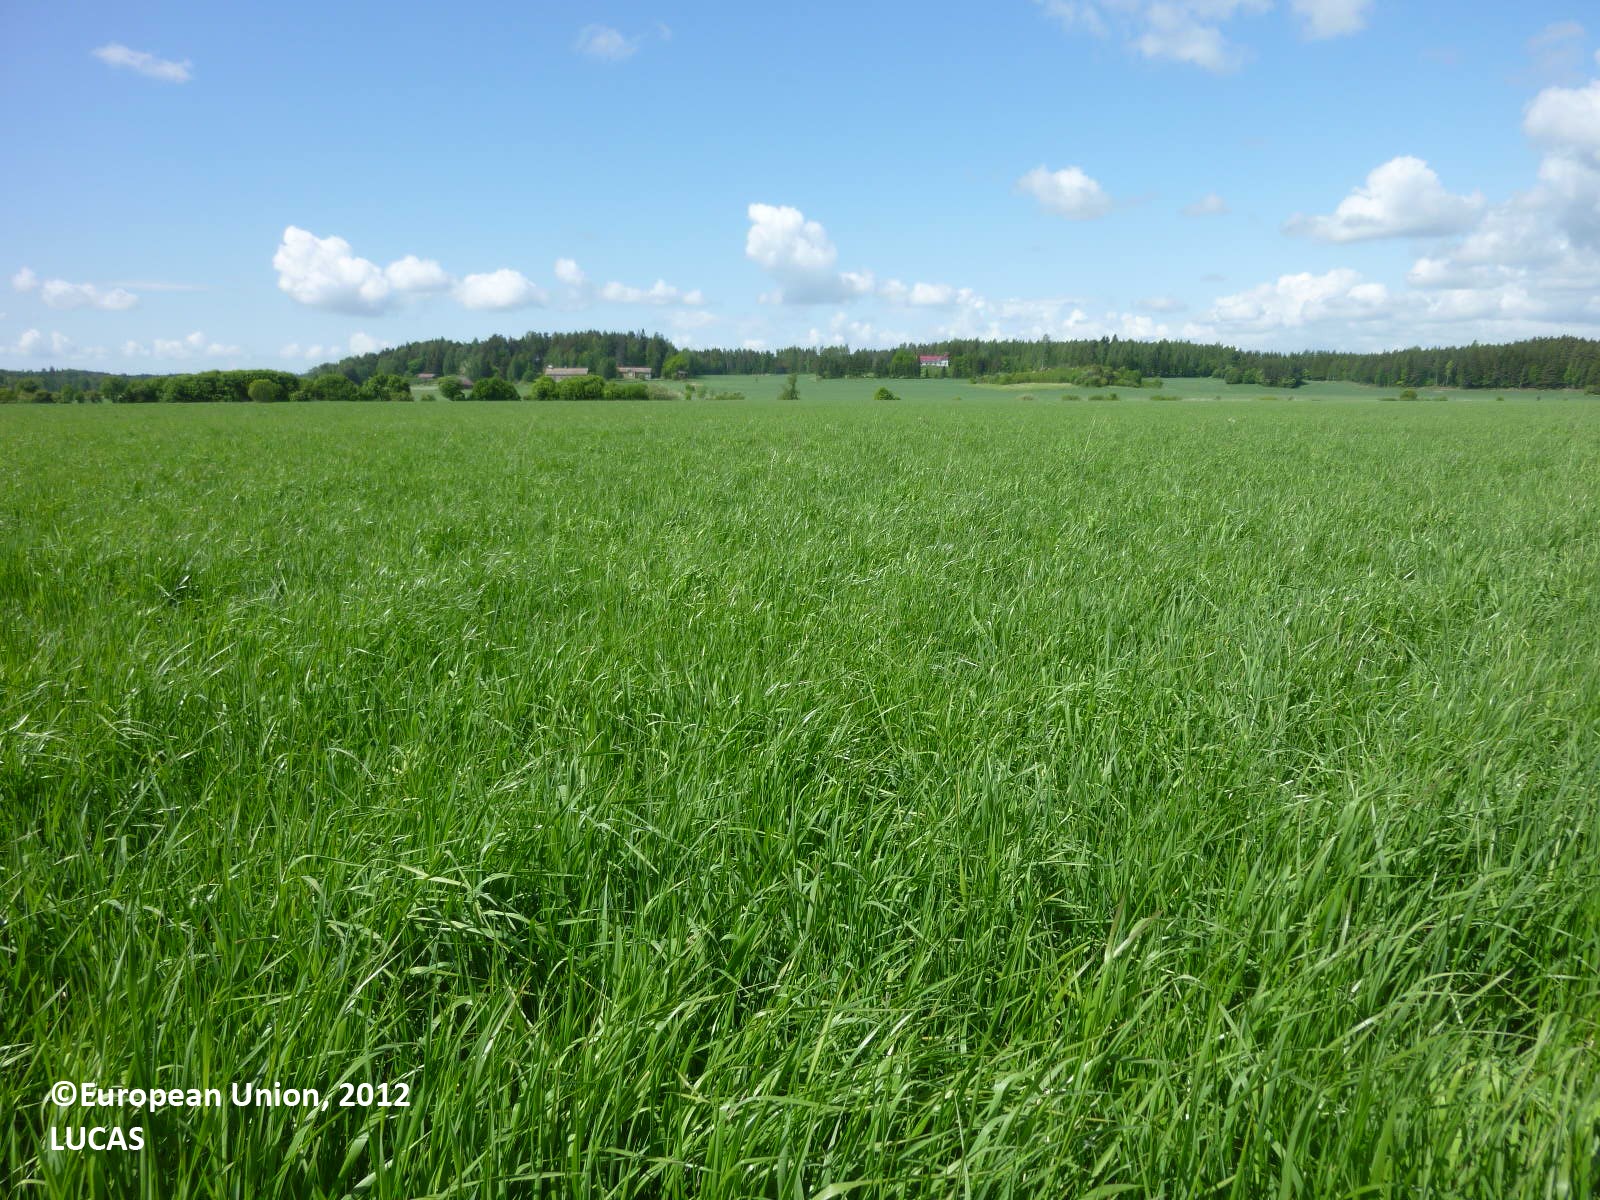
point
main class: Cropland
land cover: Temporary grasslands
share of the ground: > 75 %
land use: Agriculture (excluding fallow land and kitchen gardens)
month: June
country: FI
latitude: 60.3890
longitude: 22.4992
